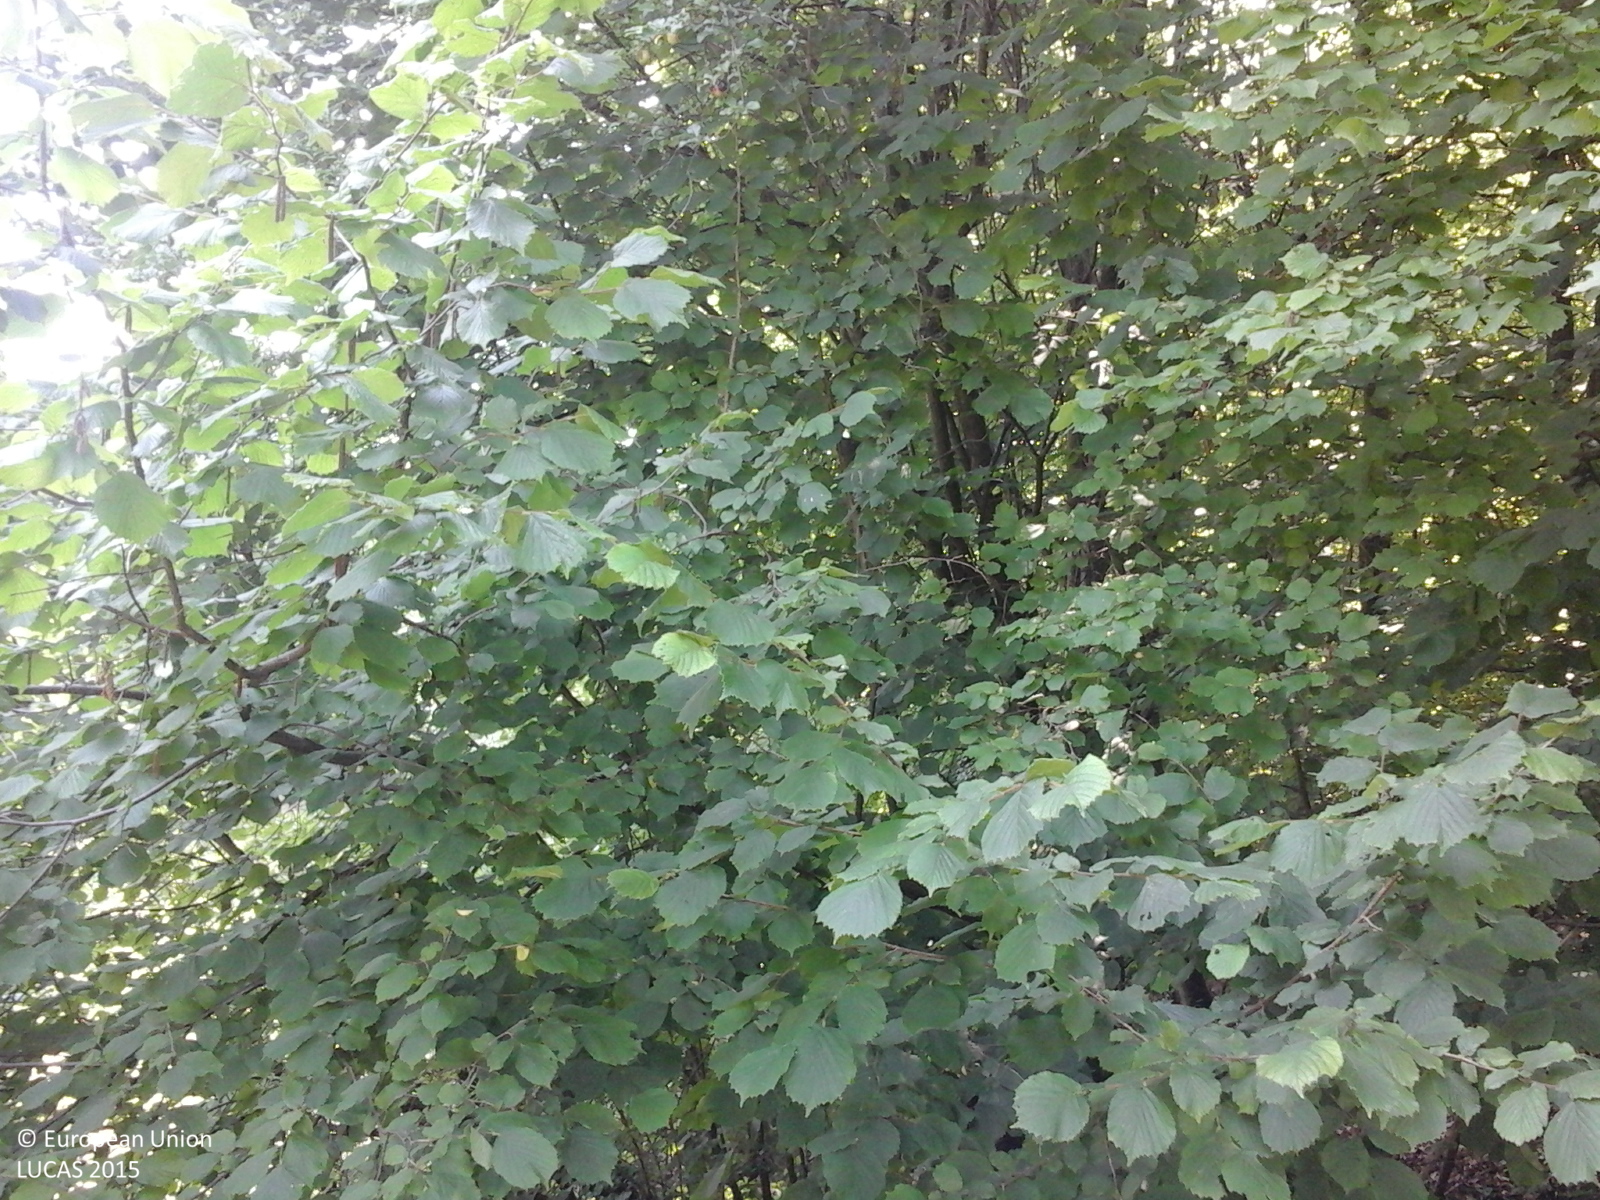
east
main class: Woodland
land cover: Broadleaved woodland
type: non-riverine alder, birch or aspen forest
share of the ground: > 75 %
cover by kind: broadleaved forest trees 100 %
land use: Forestry
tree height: > 5 m
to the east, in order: Broadleaved woodland; Arable land (only in case pi); Fences; Arable land (only in case pi); Abandoned hedges; Paved roads, cycling and walking lanes
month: July
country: RO
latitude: 45.0690
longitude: 24.5953
